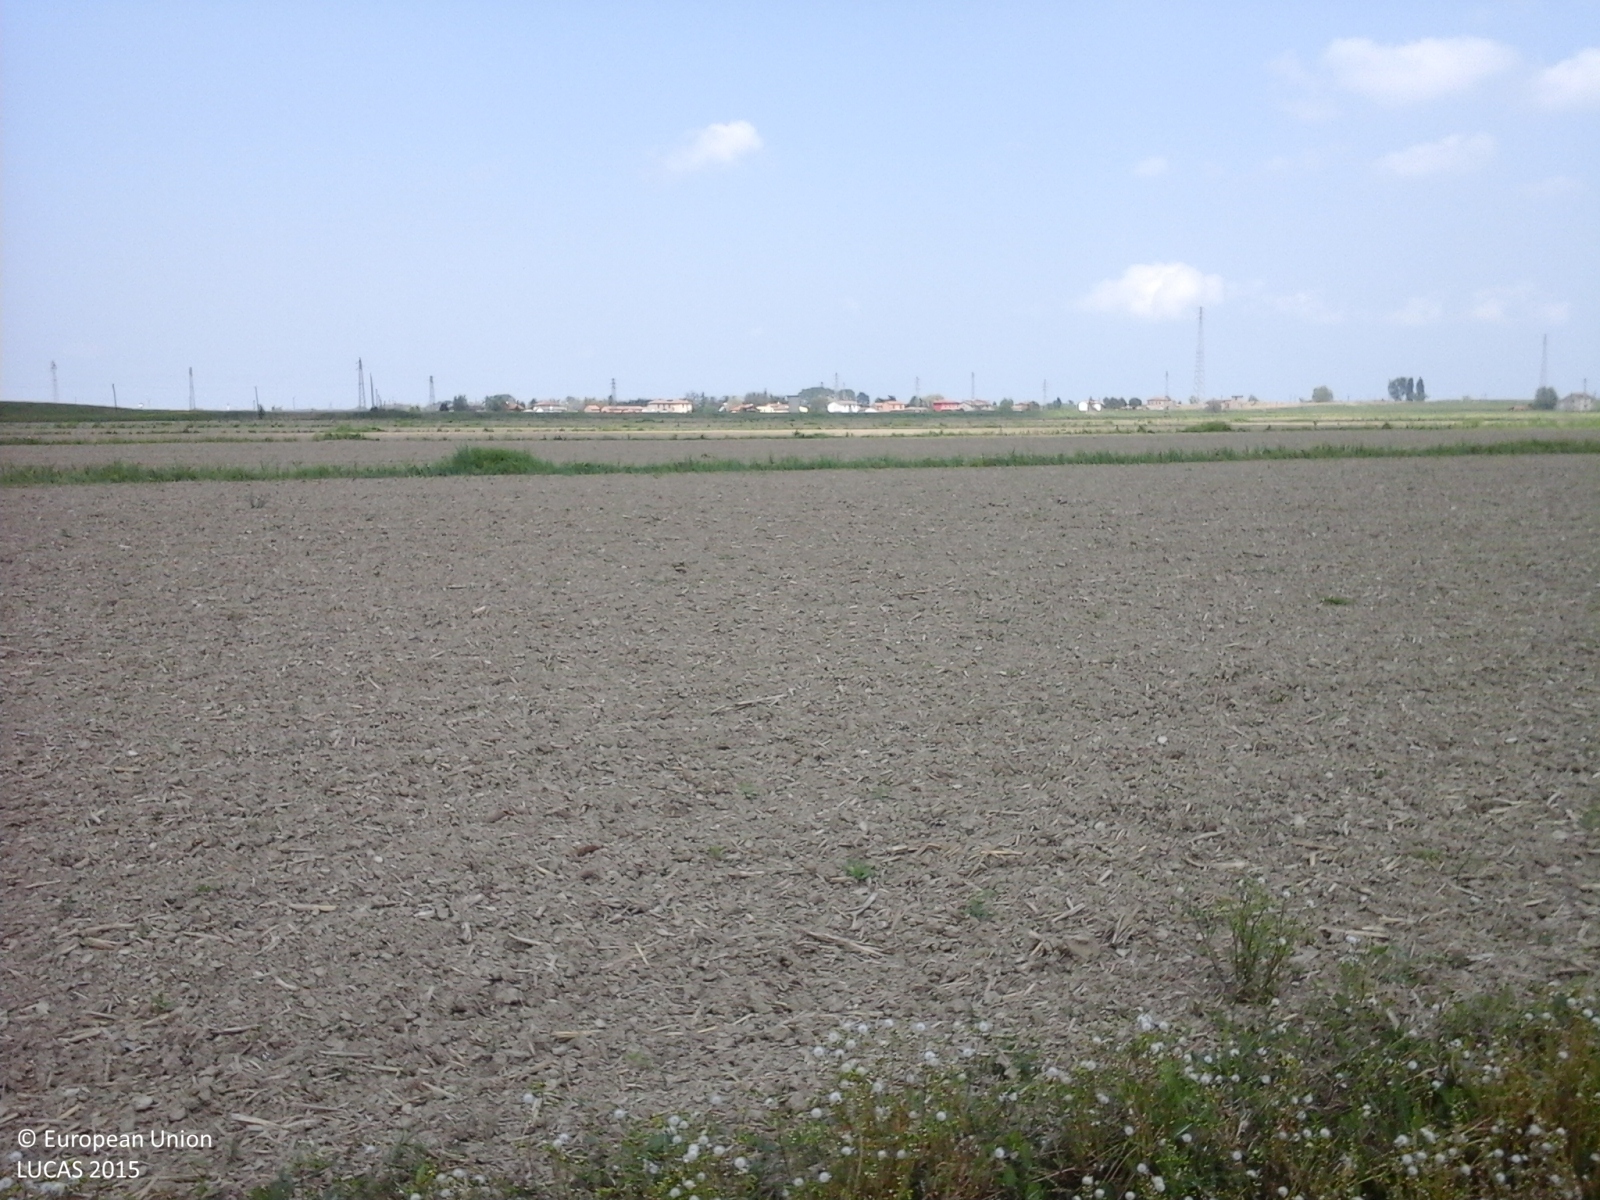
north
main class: Cropland
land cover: Maize
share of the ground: < 10 %
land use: Agriculture (excluding fallow land and kitchen gardens)
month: April
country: IT
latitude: 44.8655
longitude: 12.3371
